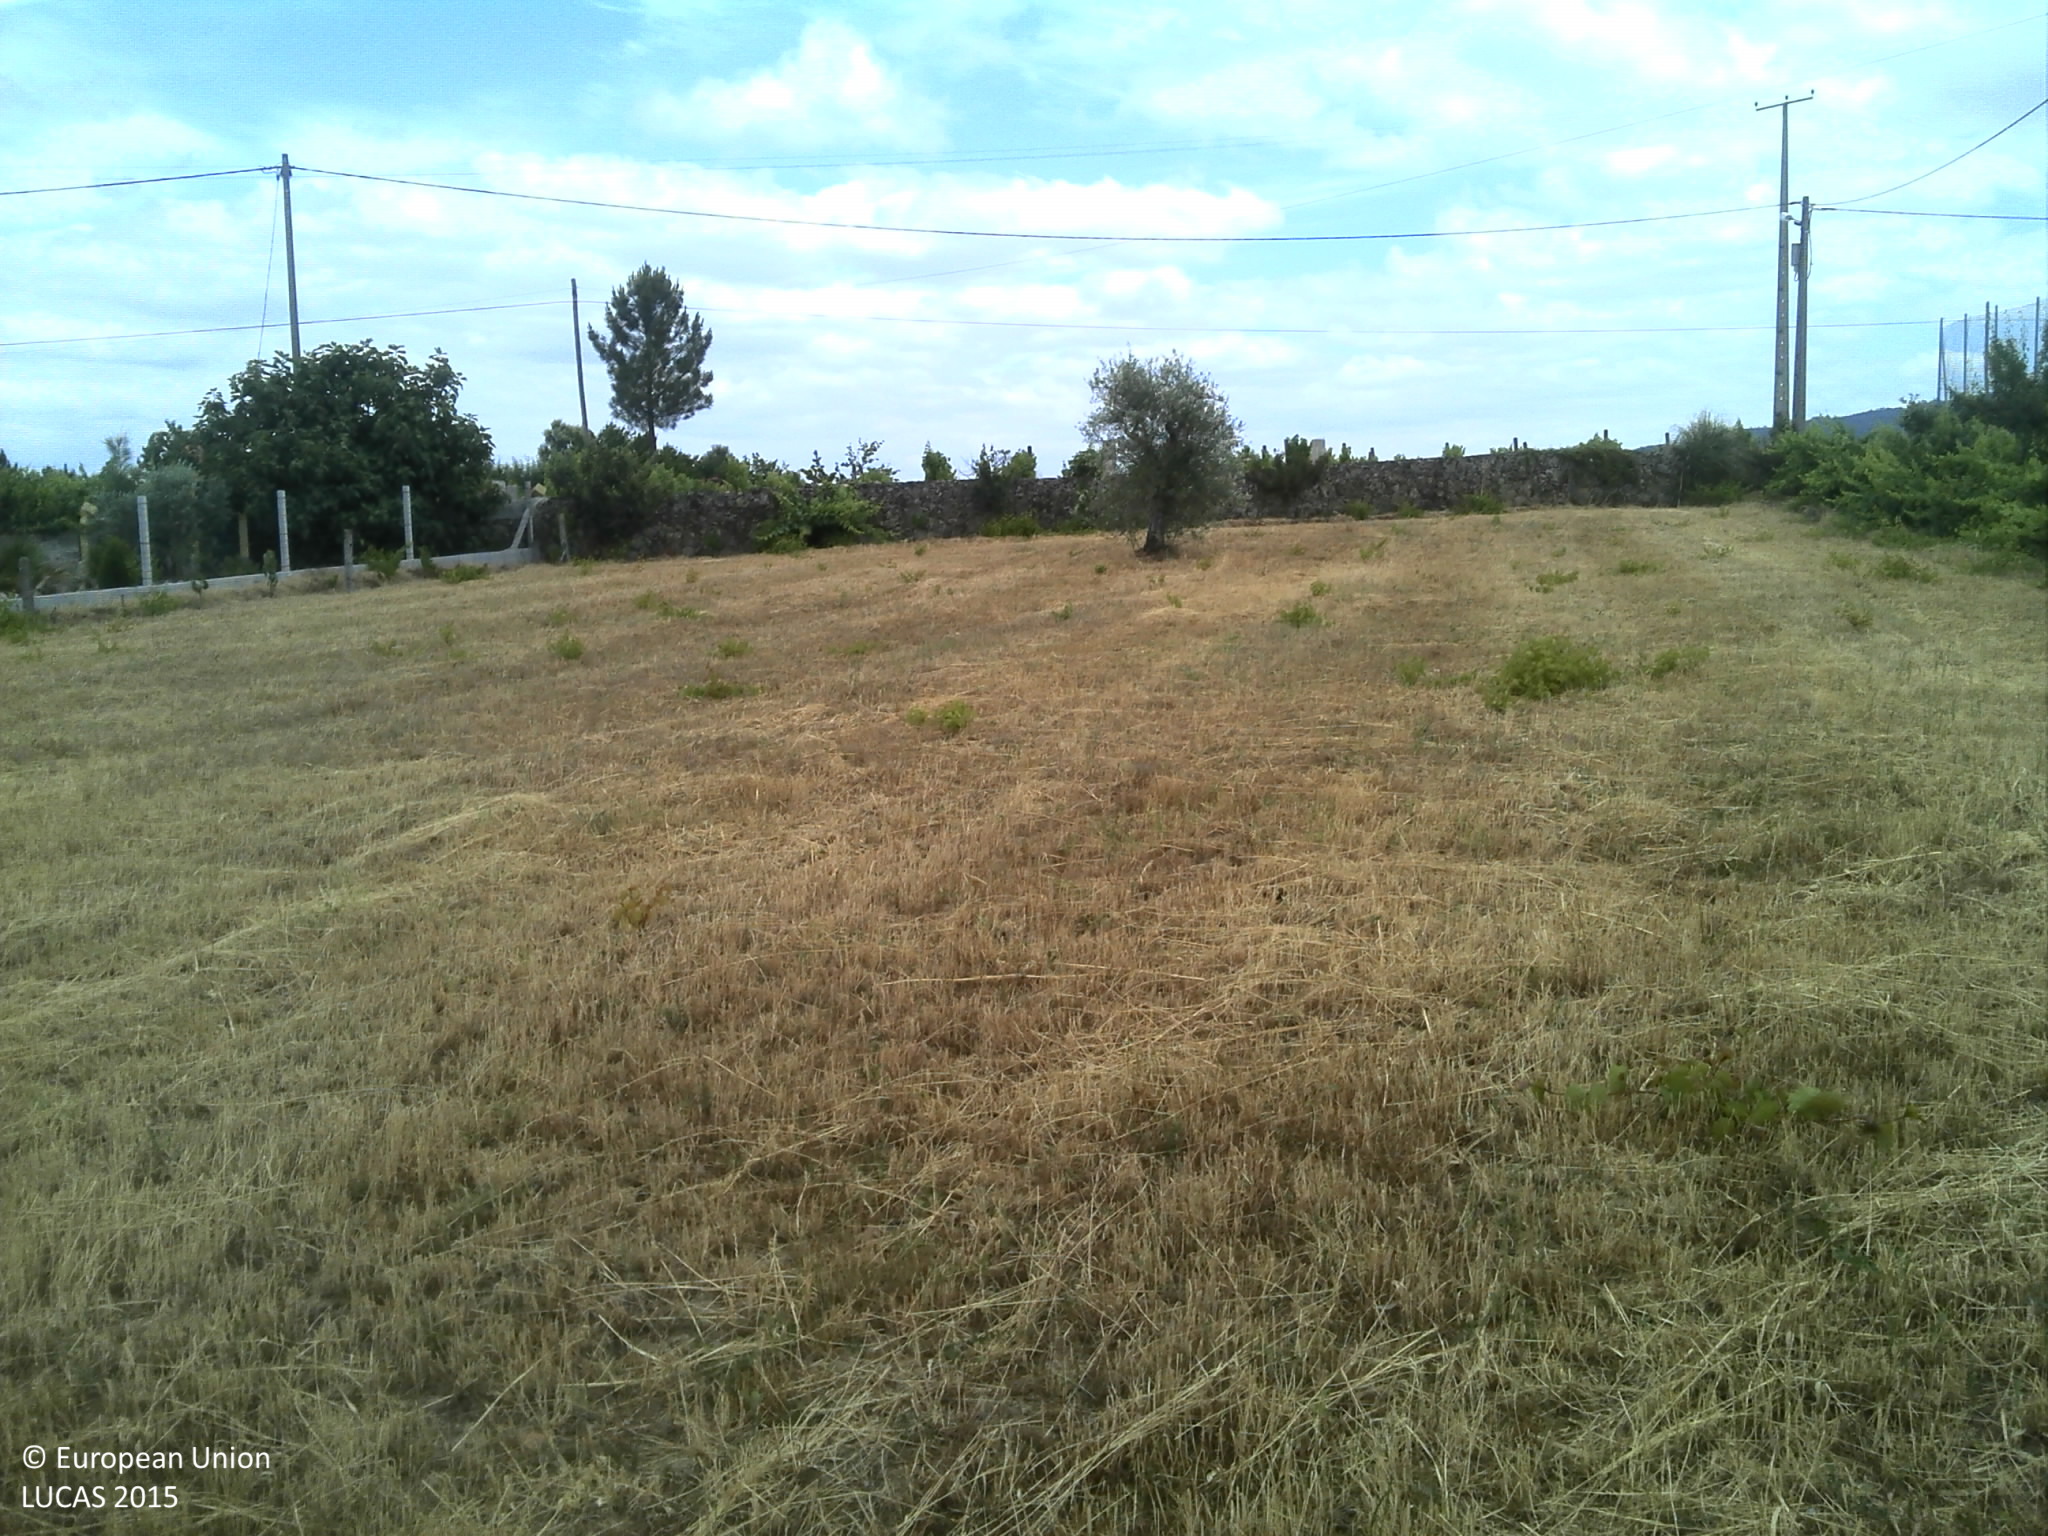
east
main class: Cropland
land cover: Oats
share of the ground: < 10 %
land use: Agriculture (excluding fallow land and kitchen gardens)
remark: Harvested field
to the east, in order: Oats; Electric lines; Oats; Electric lines; Dry stone walls; Paved roads, cycling and walking lanes; Dry stone walls; Vineyards; Electric lines; Vineyards; Tracks; Single bushes/trees; Shrubland without tree cover; Olive groves; Vineyards; Single bushes/trees; Vineyards; Single bushes/trees; Vineyards; Single bushes/trees; Vineyards; Single bushes/trees; Vineyards; Tracks
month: June
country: PT
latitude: 40.1627
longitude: -7.4697
